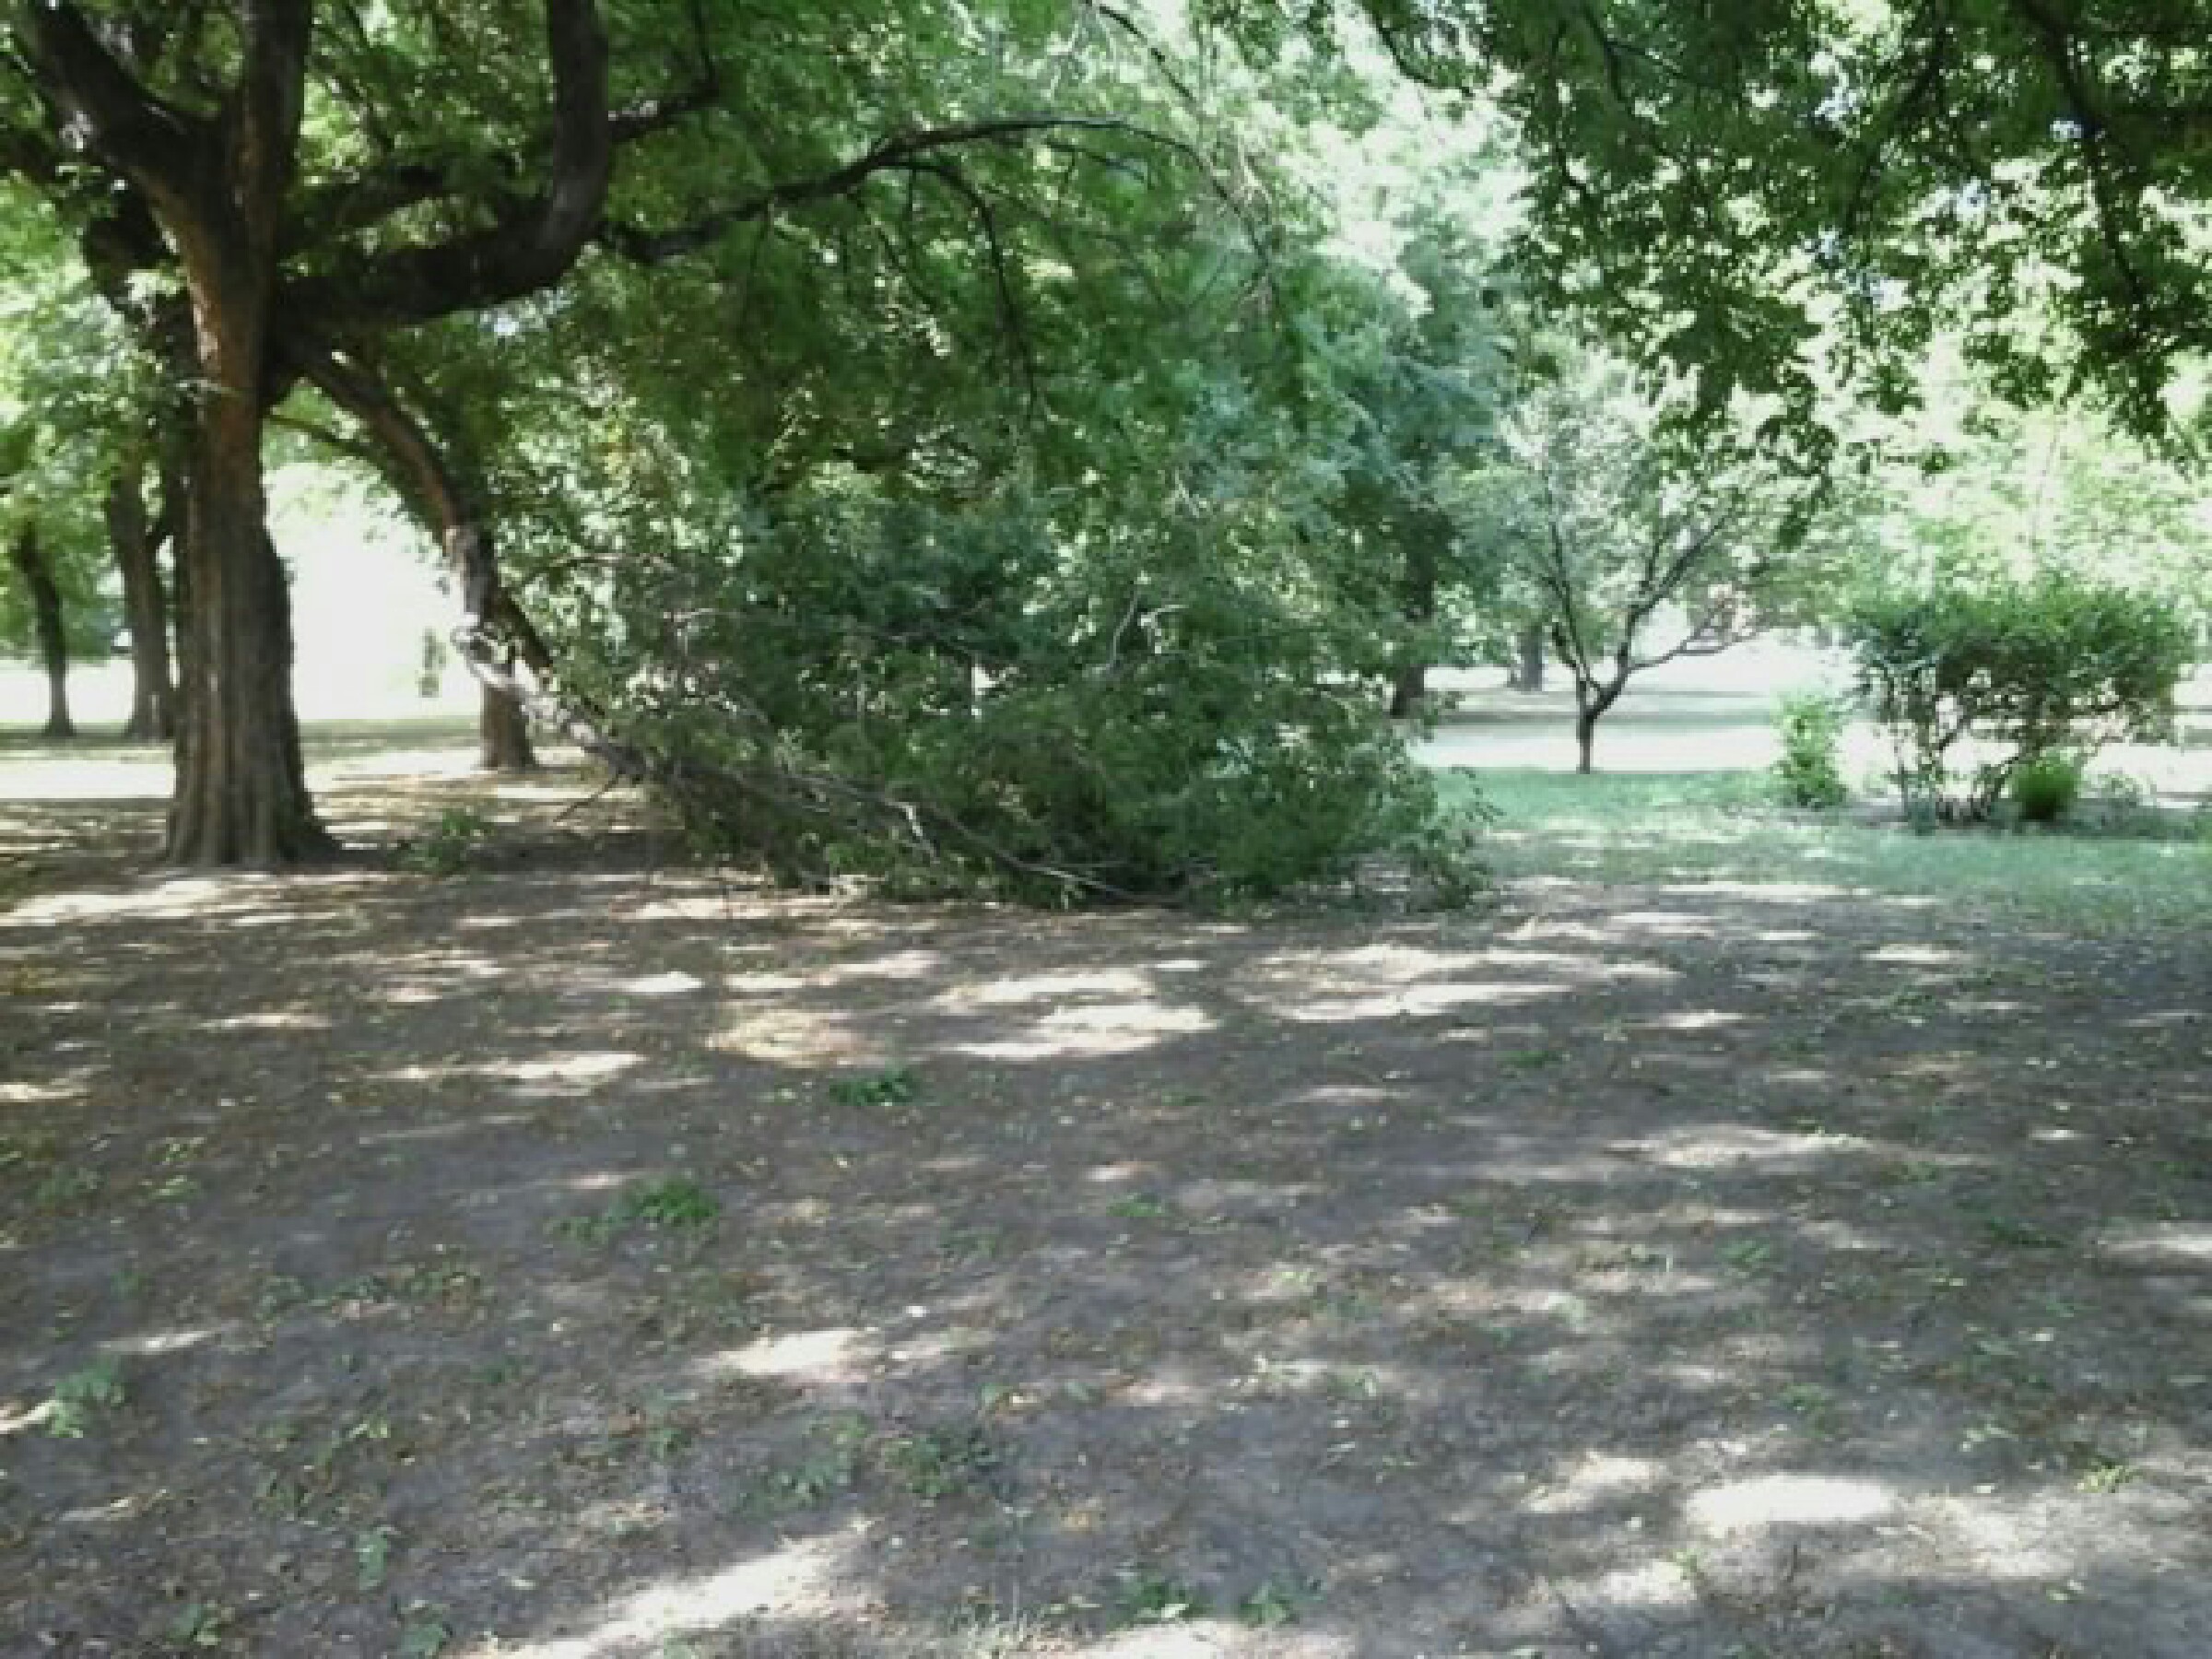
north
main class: Woodland
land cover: Broadleaved woodland
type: mesophytic deciduous forest
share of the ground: > 75 %
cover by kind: broadleaved forest trees 95 %, herbaceous plants 5 %
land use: Amenities, museums, leisure
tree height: > 5 m
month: July
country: HU
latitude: 47.6799
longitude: 19.1438
